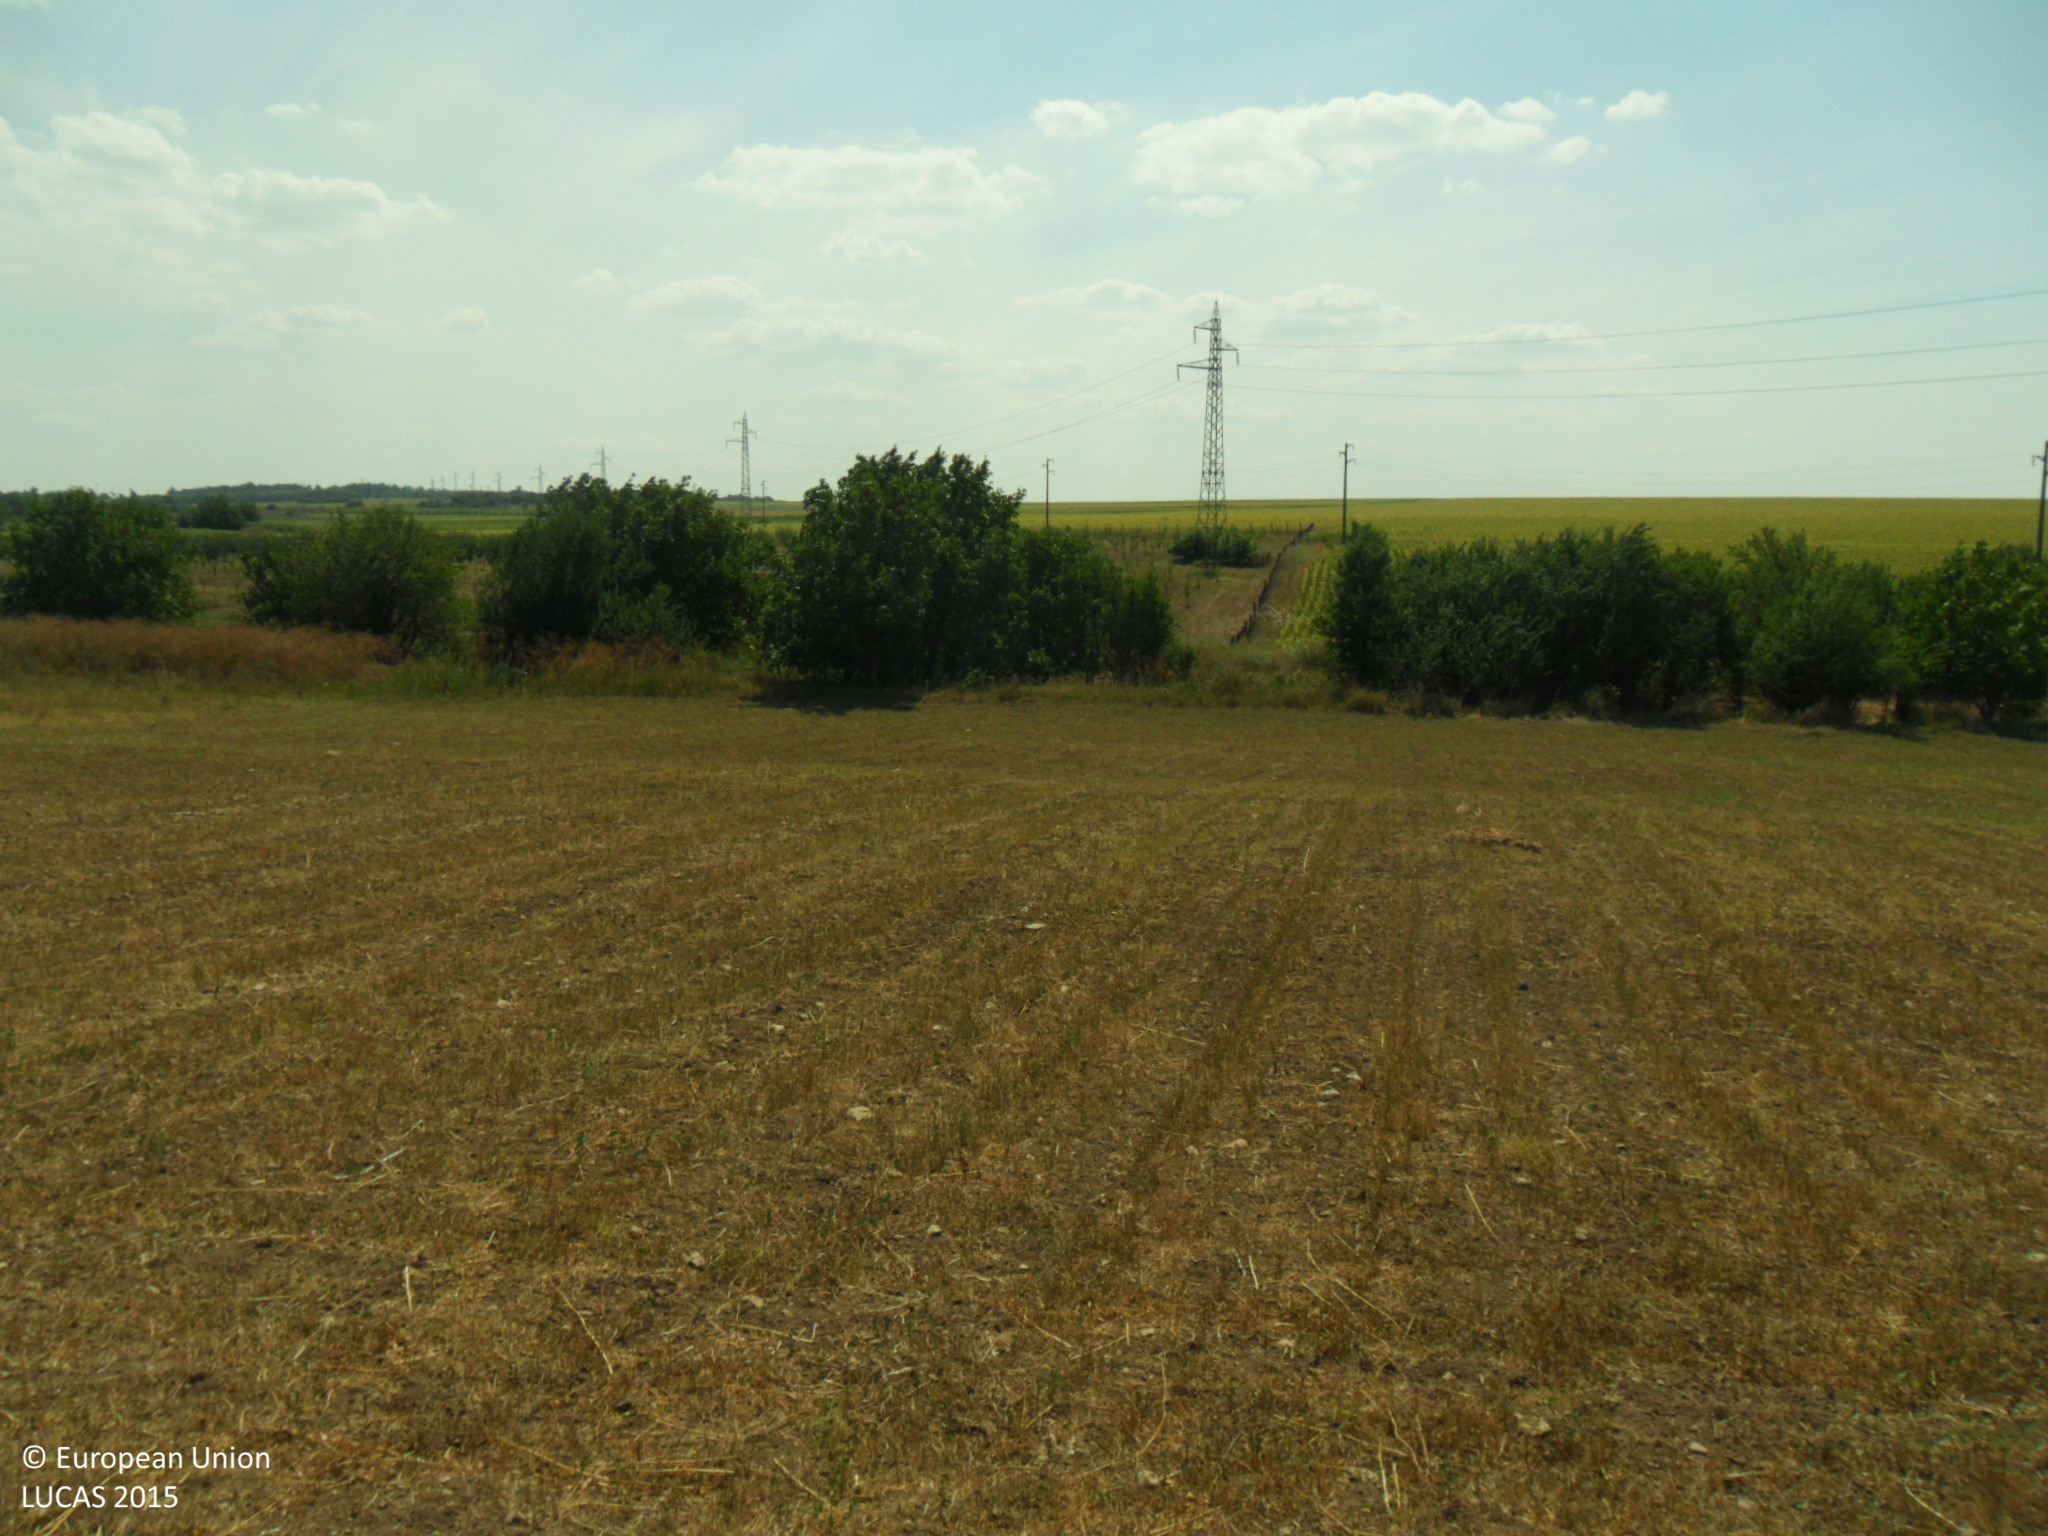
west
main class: Grassland
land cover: Grassland with sparse tree/shrub cover
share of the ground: > 75 %
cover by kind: herbaceous plants 90 %, broadleaved forest trees 5 %, shrubs 5 %
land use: Agriculture (excluding fallow land and kitchen gardens)
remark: Harvested field
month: August
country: BG
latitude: 43.5418
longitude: 27.1132
